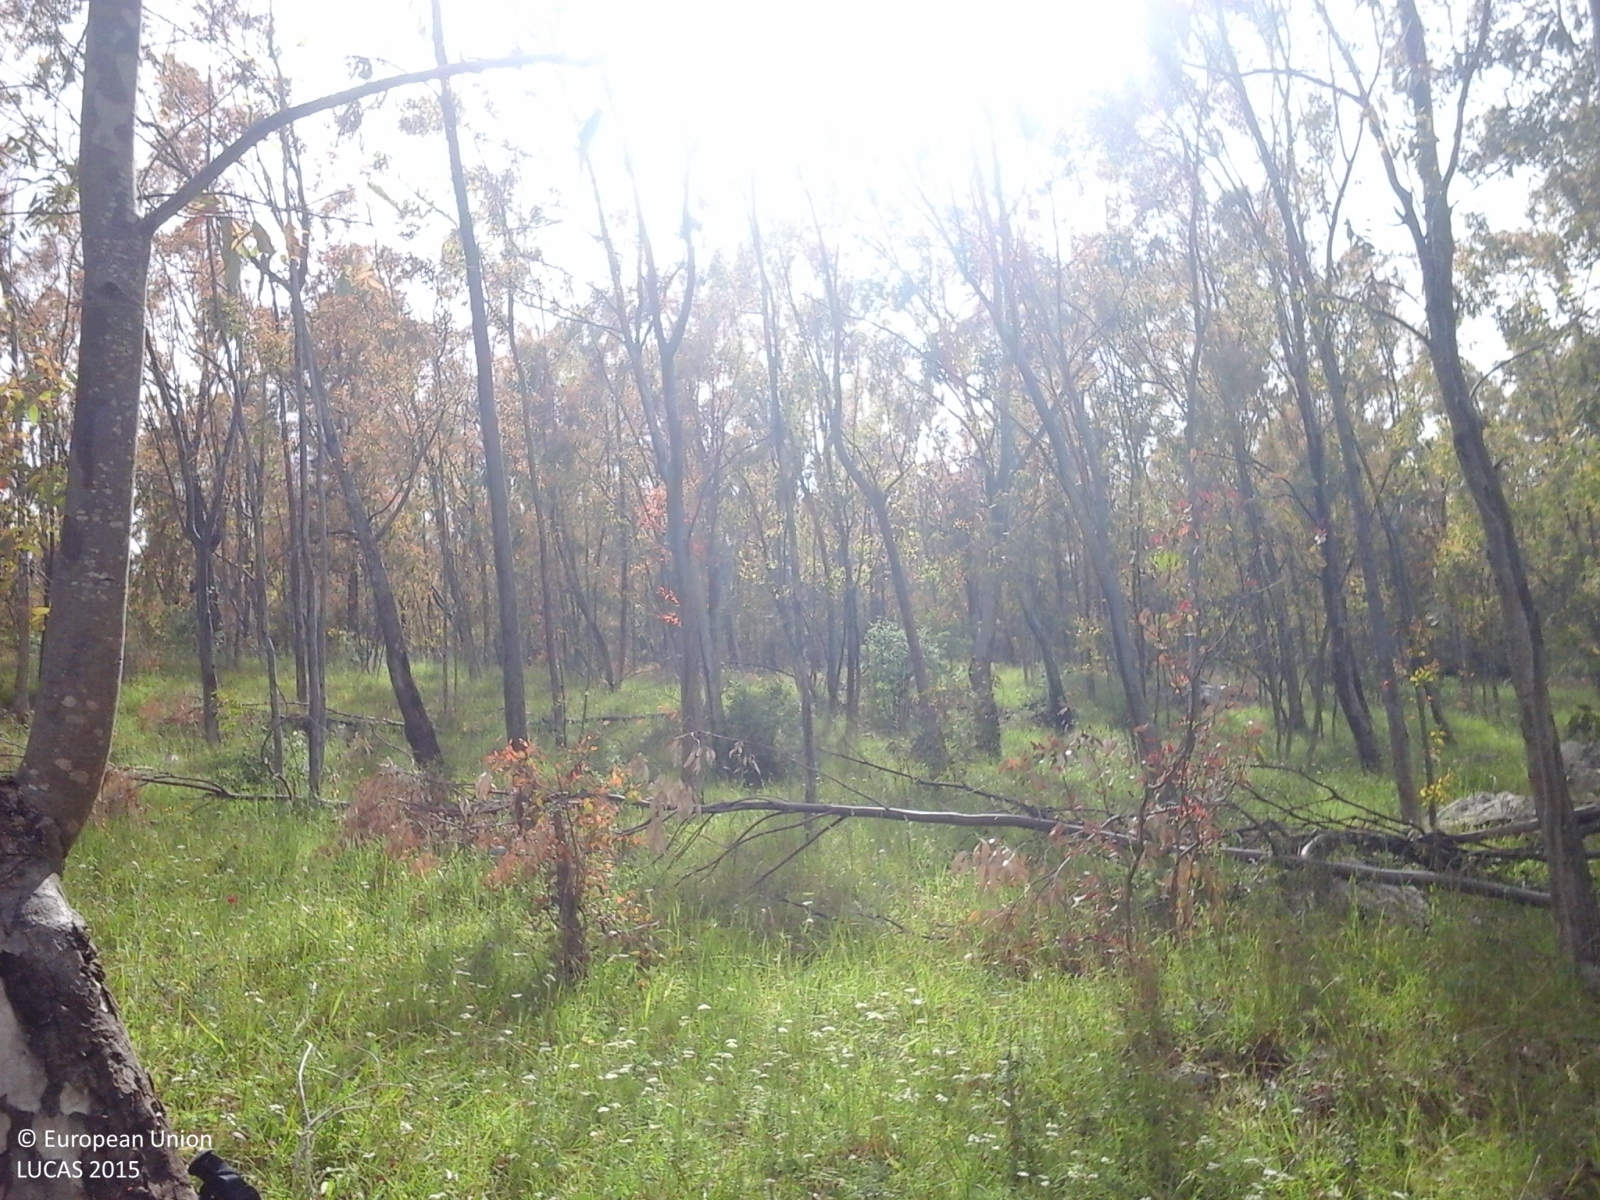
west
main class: Woodland
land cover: Broadleaved woodland
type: broadleaved evergreen forest
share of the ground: > 75 %
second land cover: Grassland without tree/shrub cover
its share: > 75 %
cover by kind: broadleaved forest trees 80 %, herbaceous plants 10 %, shrubs 5 %, consolidated bare surface 5 %
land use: Forestry
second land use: Agriculture (excluding fallow land and kitchen gardens)
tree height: > 5 m
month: May
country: IT
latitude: 37.8259
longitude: 14.4338
